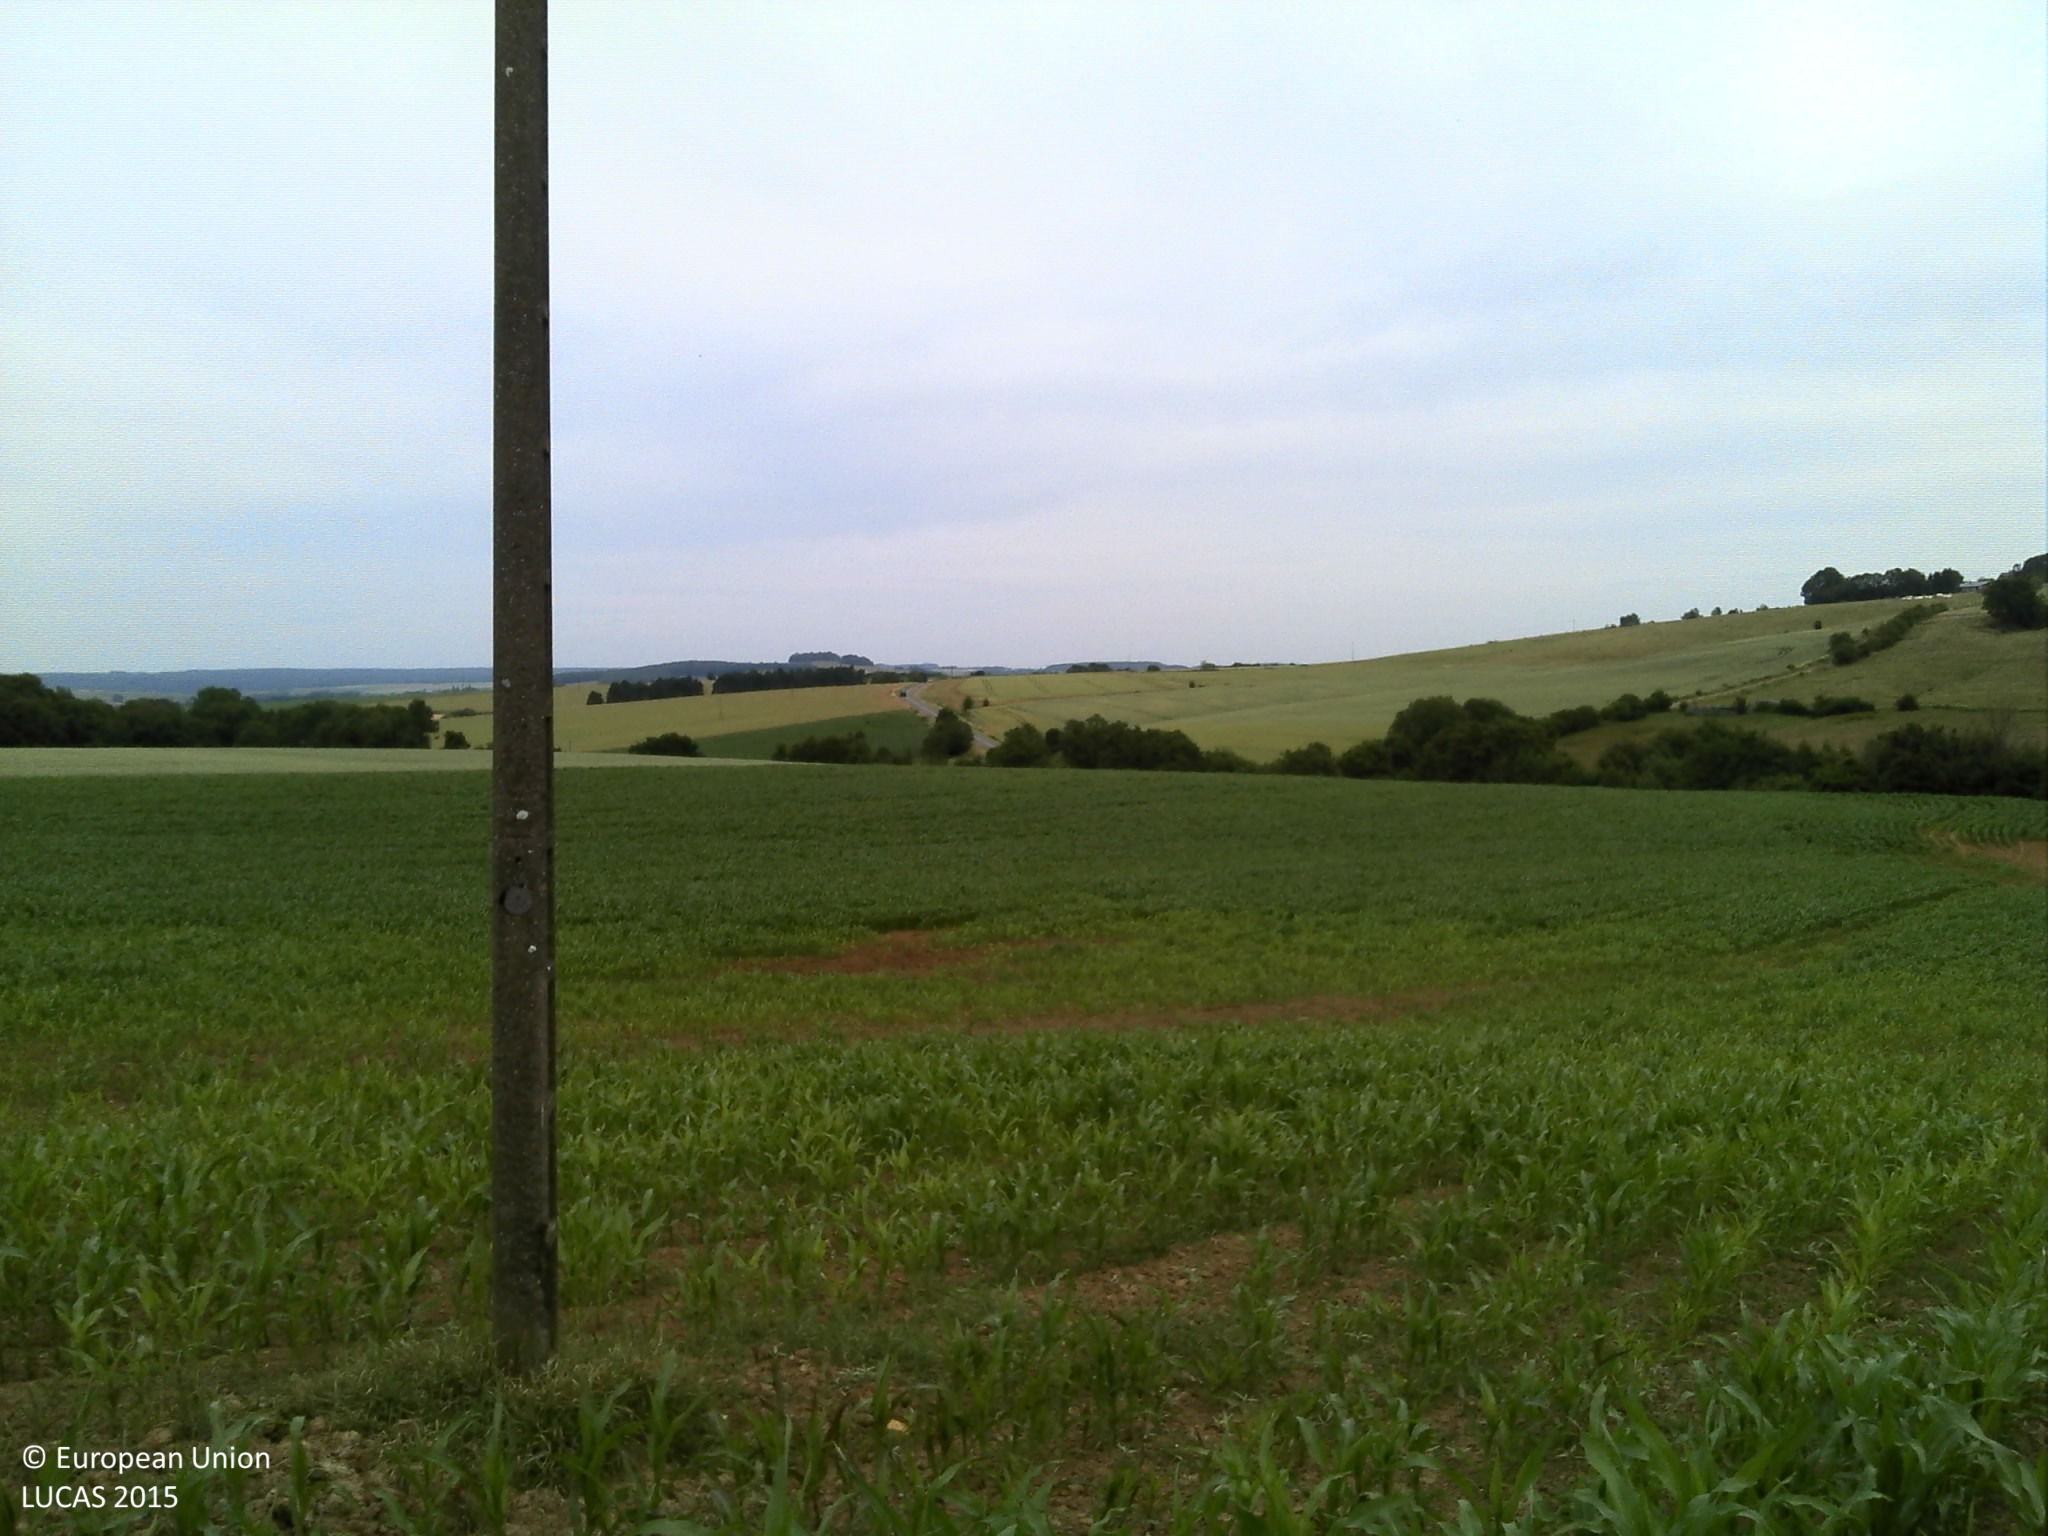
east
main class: Cropland
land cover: Maize
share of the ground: 25 - 50 %
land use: Agriculture (excluding fallow land and kitchen gardens)
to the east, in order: Maize; Electric lines; Maize
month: June
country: FR
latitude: 49.6110
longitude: 5.1124
